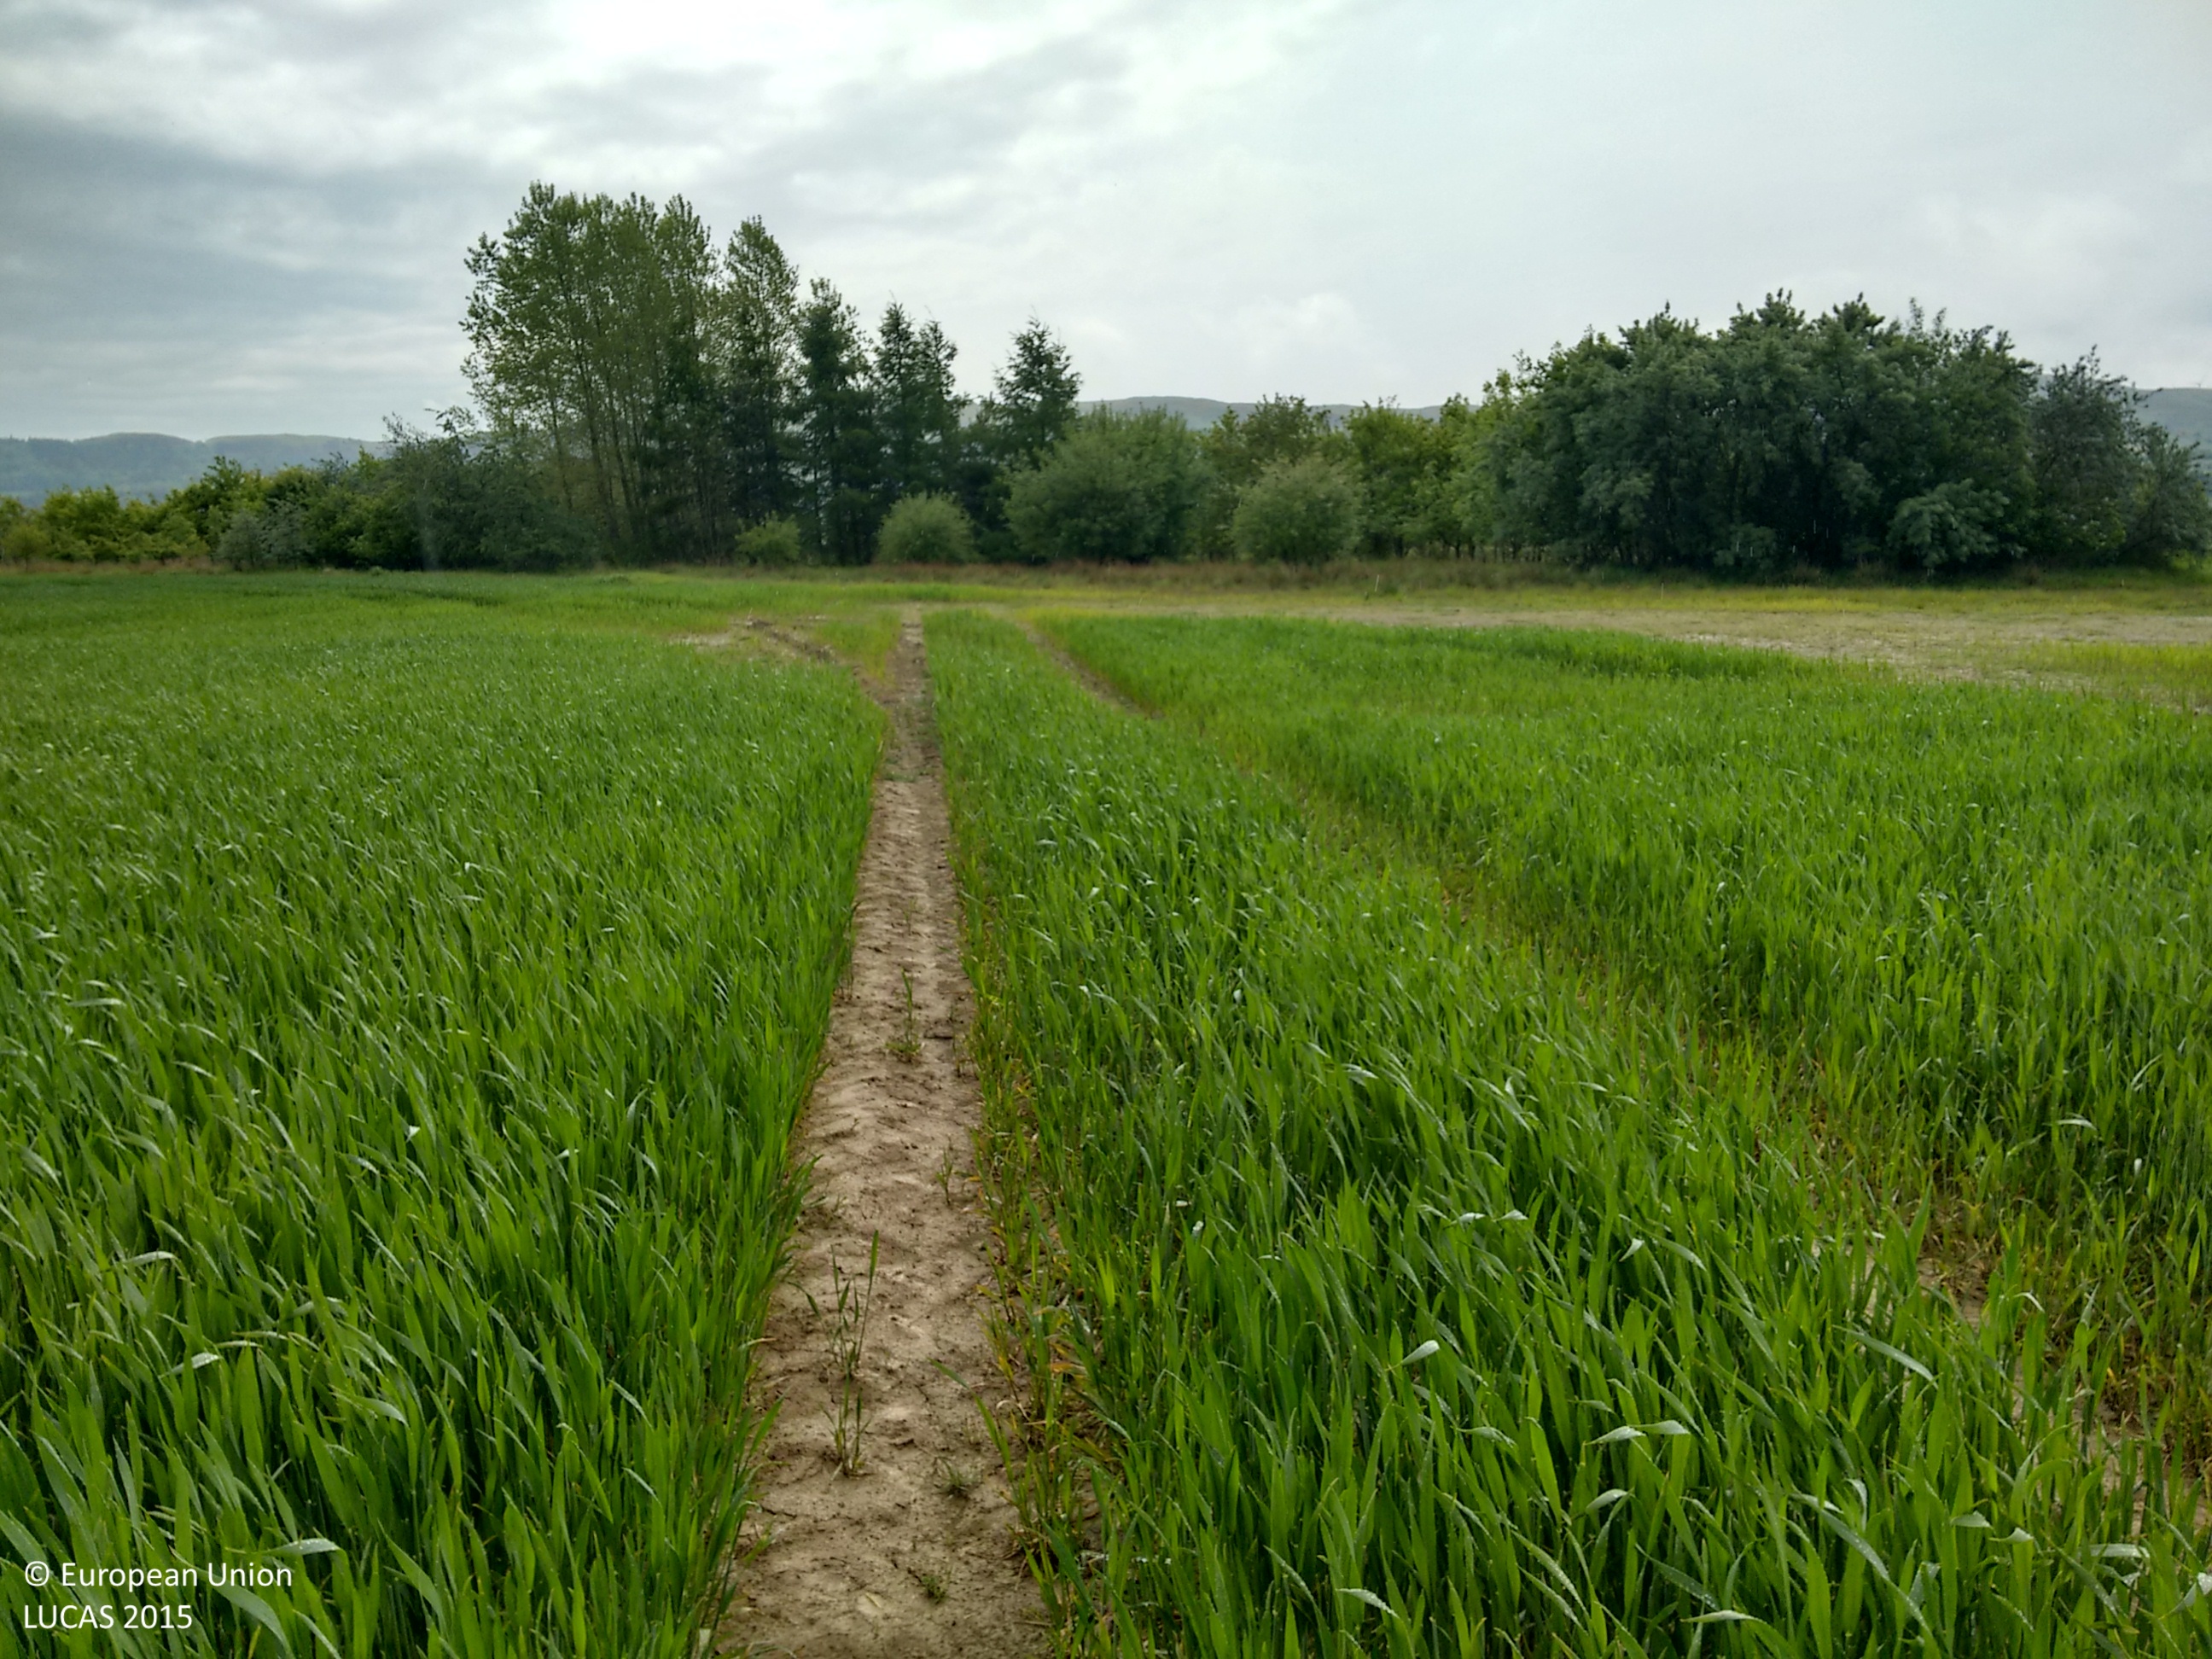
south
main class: Cropland
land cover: Common wheat
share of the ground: > 75 %
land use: Agriculture (excluding fallow land and kitchen gardens)
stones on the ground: < 10 %
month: June
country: GB
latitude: 56.3401
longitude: -3.3875
